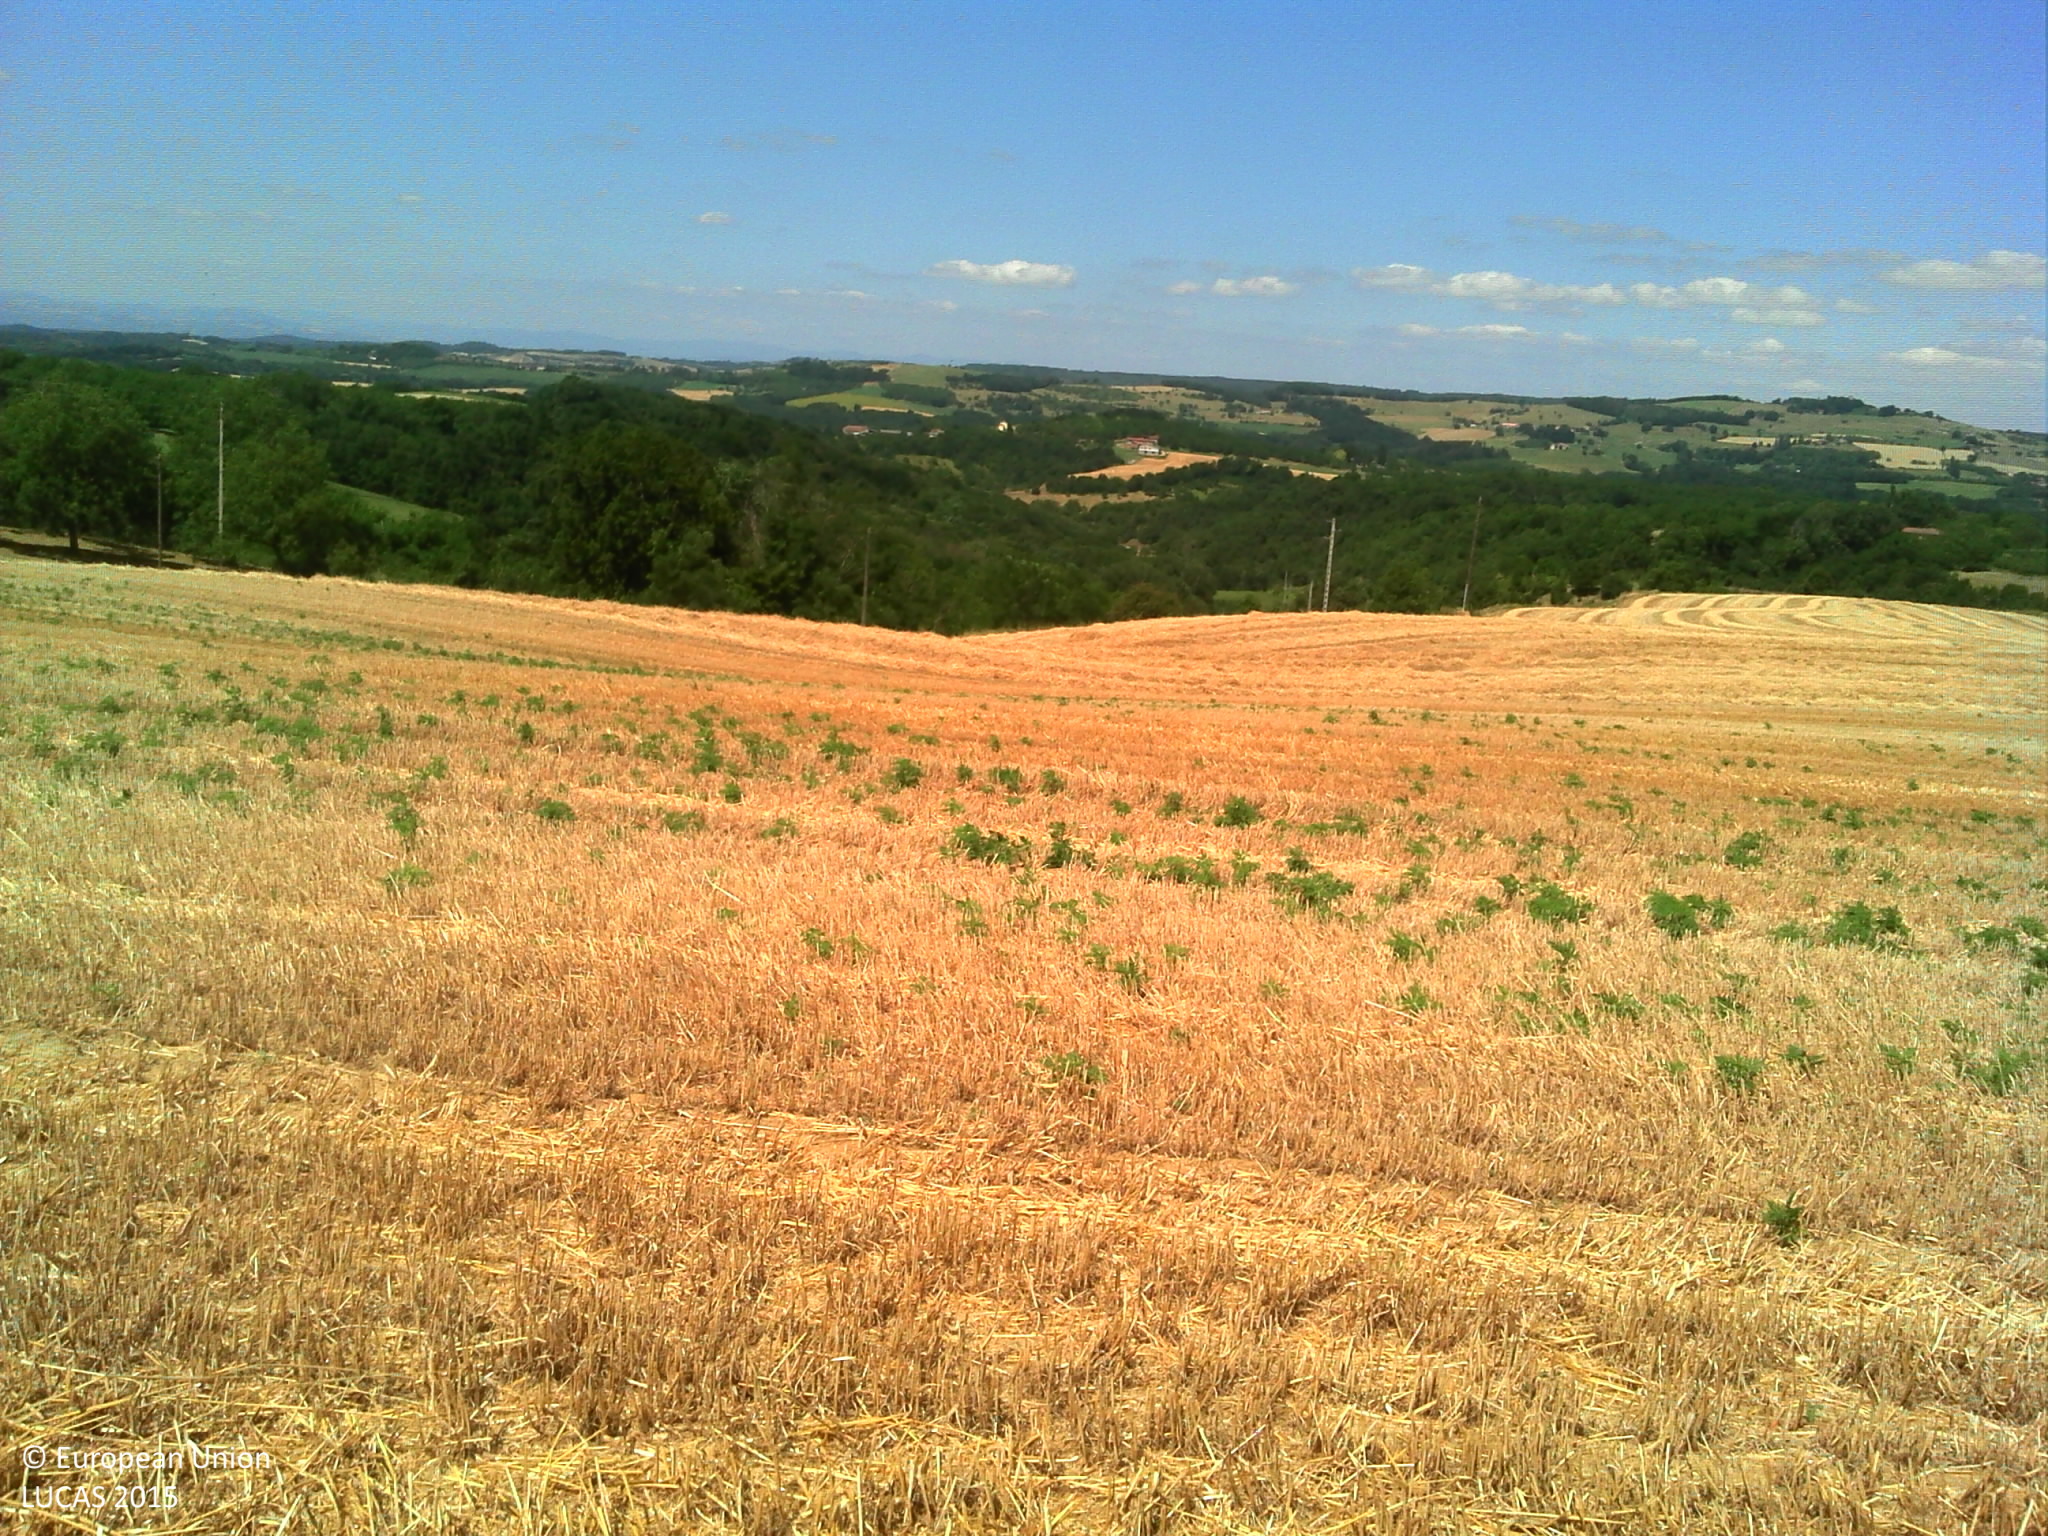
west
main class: Cropland
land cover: Barley
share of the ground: > 75 %
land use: Agriculture (excluding fallow land and kitchen gardens)
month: July
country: FR
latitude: 45.1239
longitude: 5.1871
